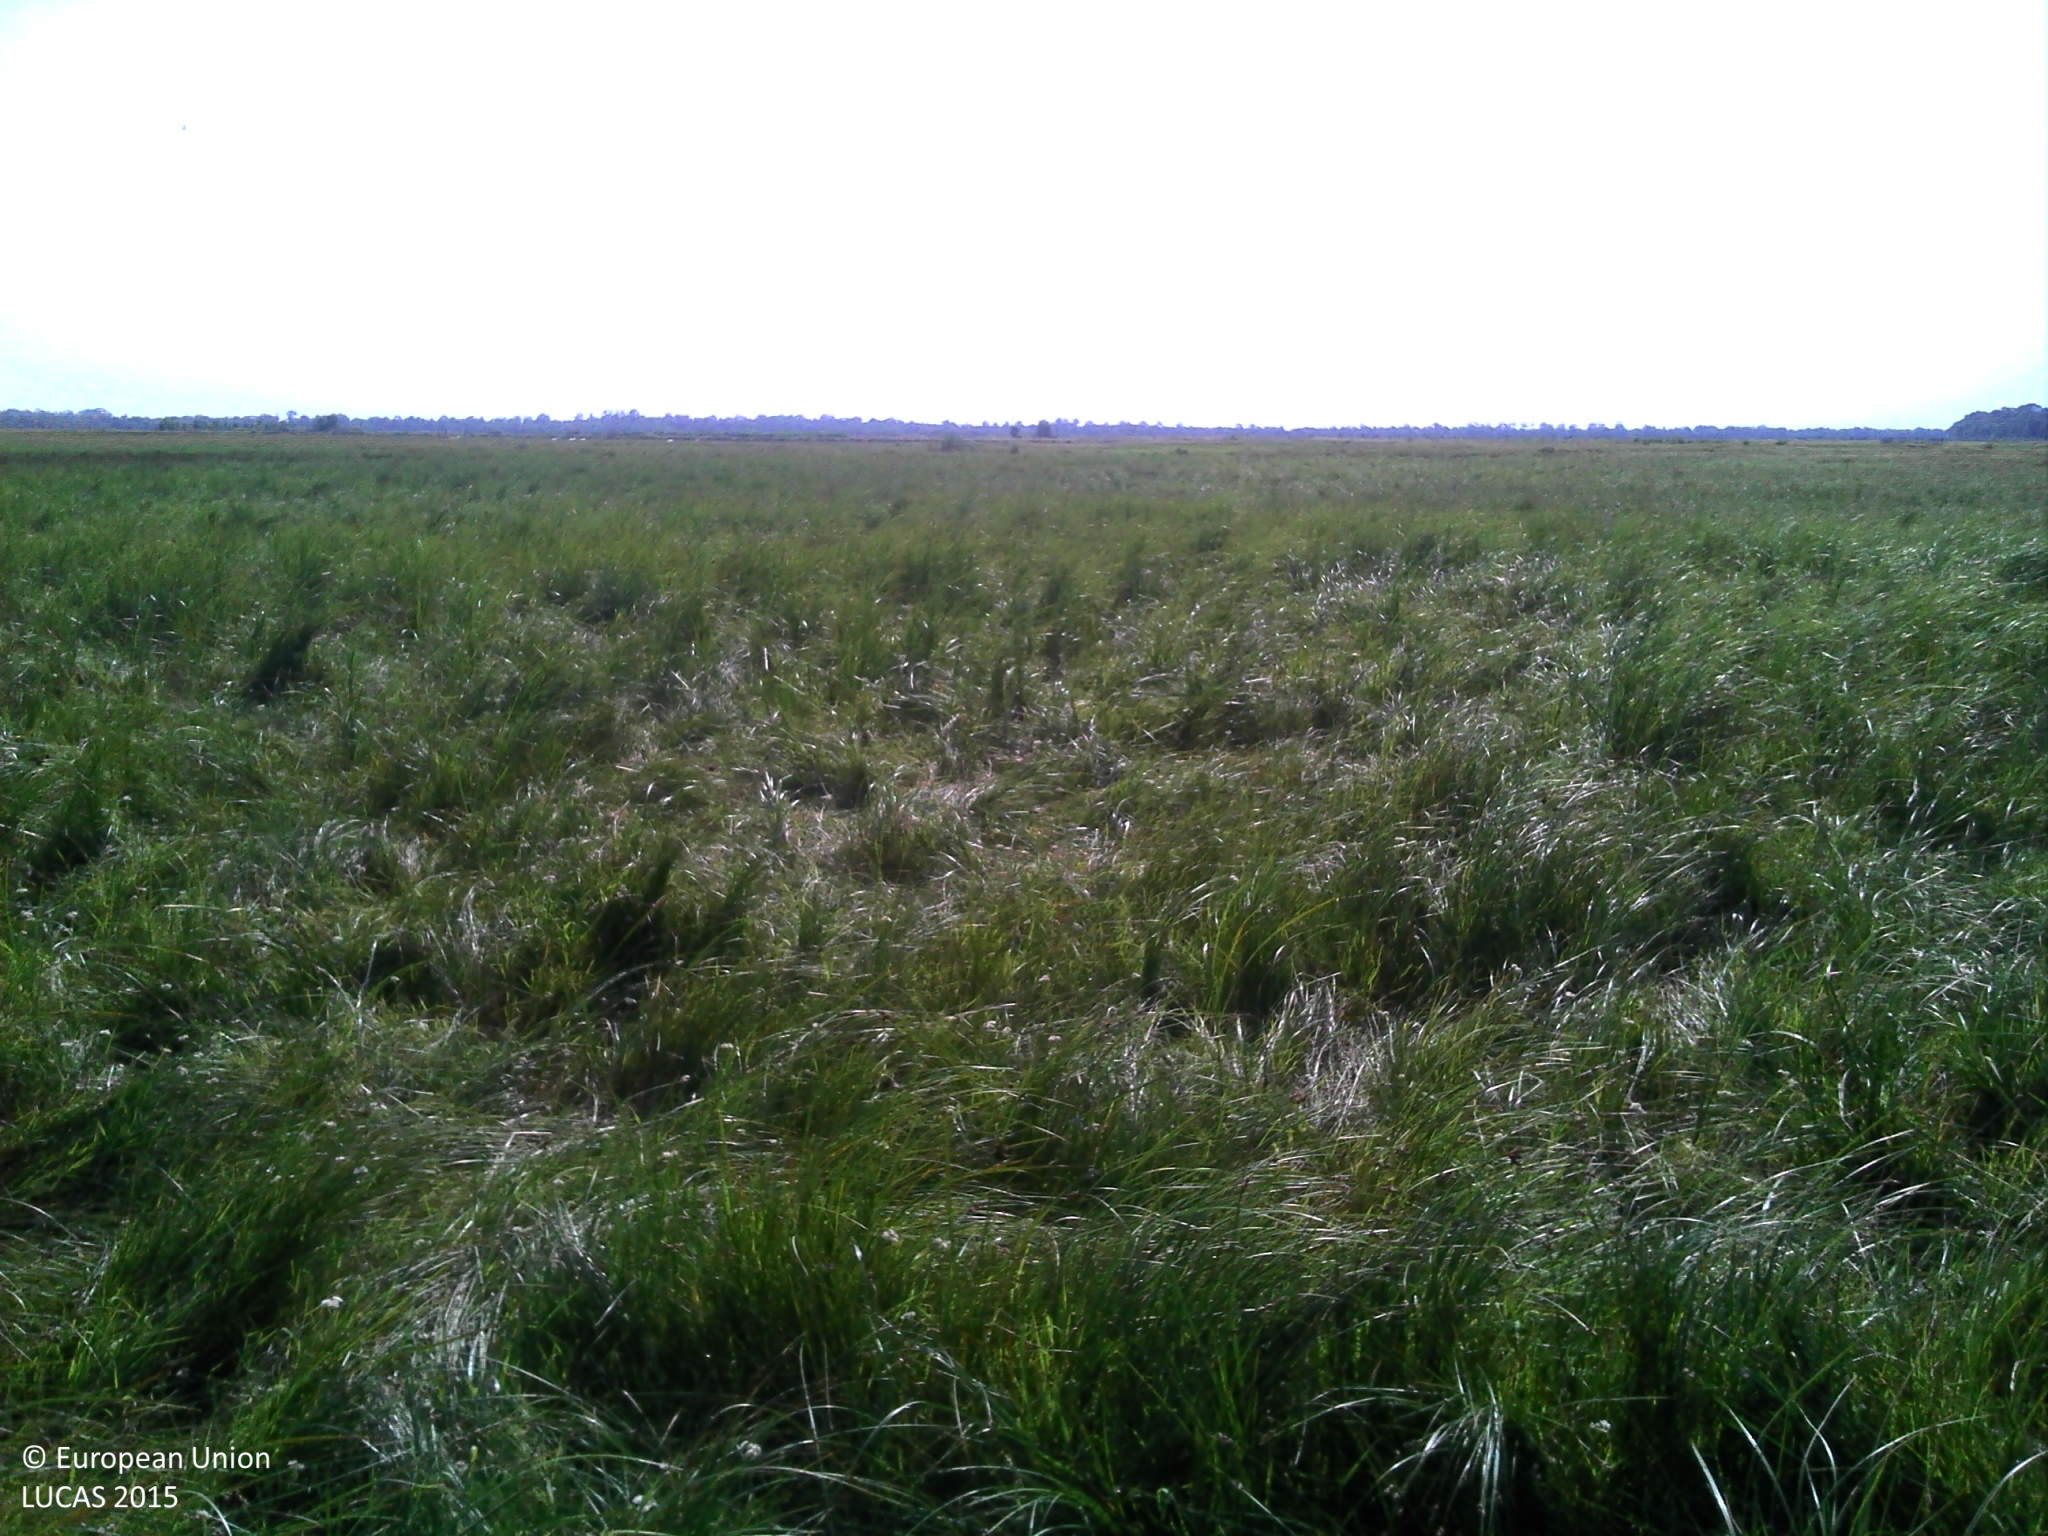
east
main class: Grassland
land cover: Grassland without tree/shrub cover
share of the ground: > 75 %
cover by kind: herbaceous plants 95 %, shrubs 5 %
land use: Agriculture (excluding fallow land and kitchen gardens)
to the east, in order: Grassland without tree/shrub cover; Inland fresh running water; Grassland without tree/shrub cover; Inland marshes; Grassland without tree/shrub cover
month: June
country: FR
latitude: 46.0161
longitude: -1.0213
